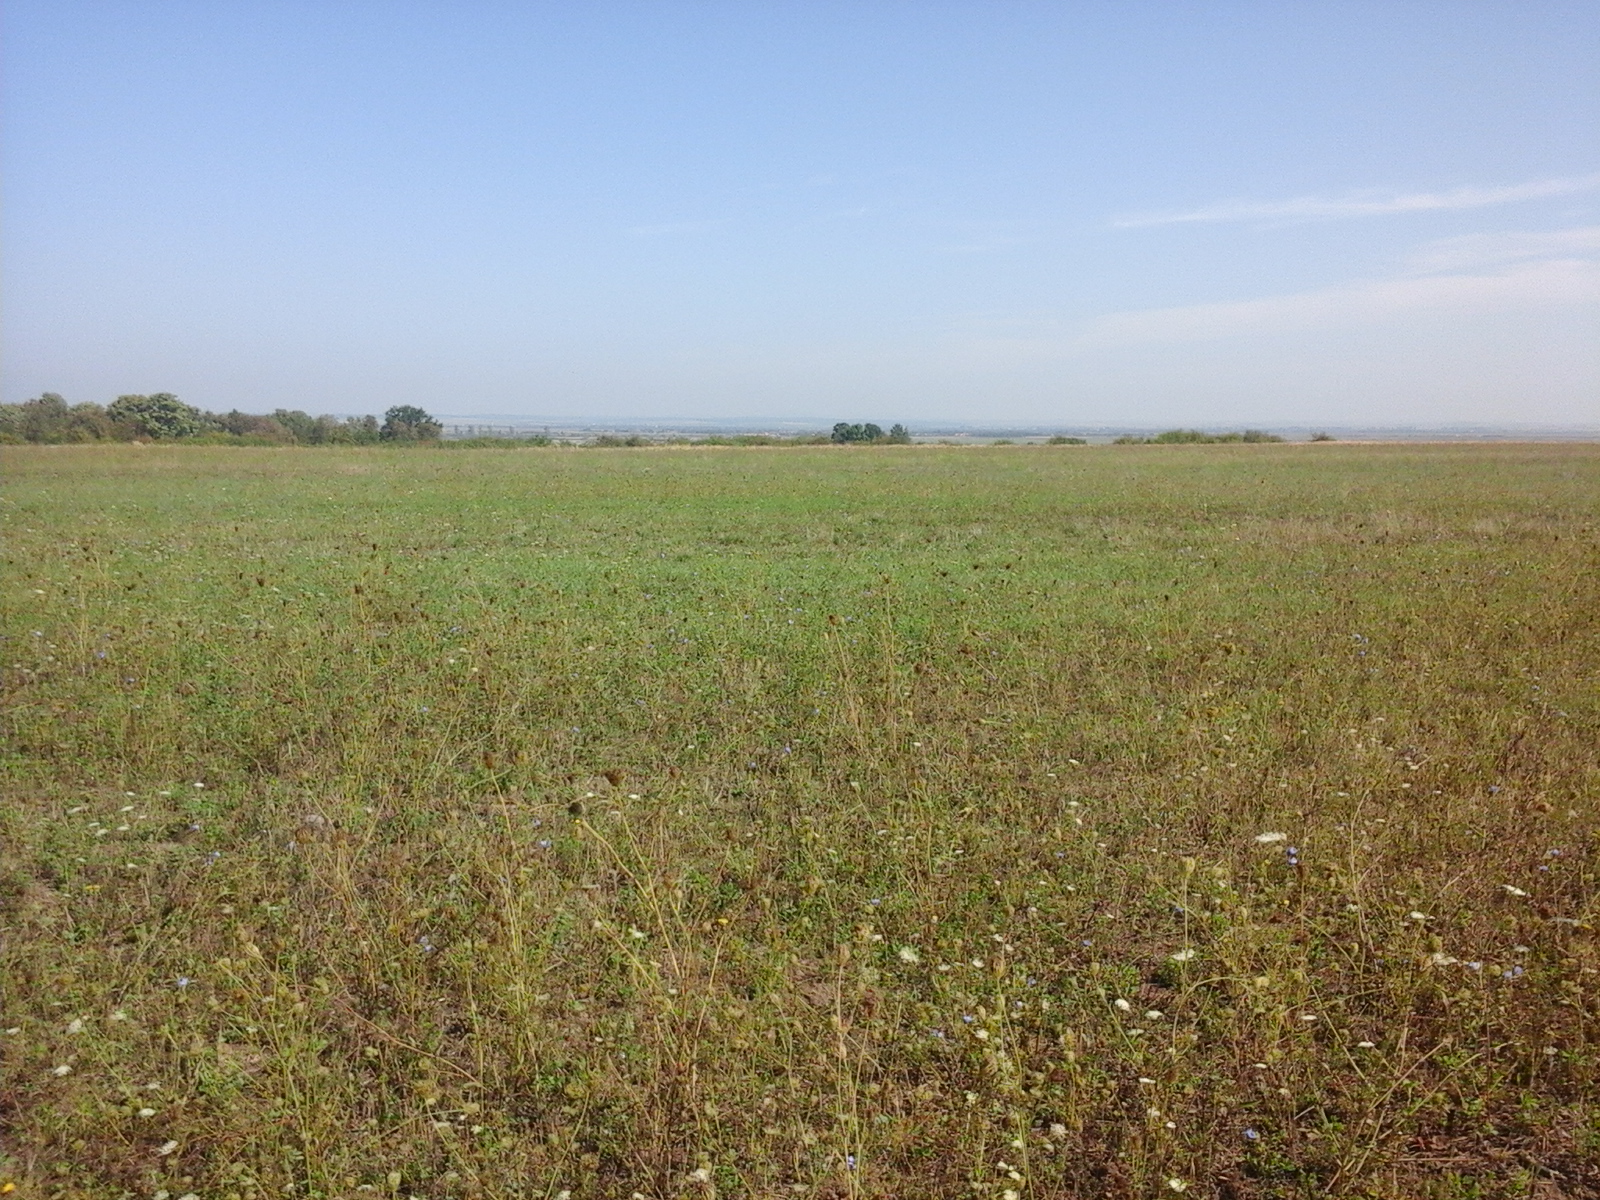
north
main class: Grassland
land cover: Grassland without tree/shrub cover
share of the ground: > 75 %
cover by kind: herbaceous plants 100 %
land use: Agriculture (excluding fallow land and kitchen gardens)
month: August
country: RO
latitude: 45.6670
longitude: 21.7293
